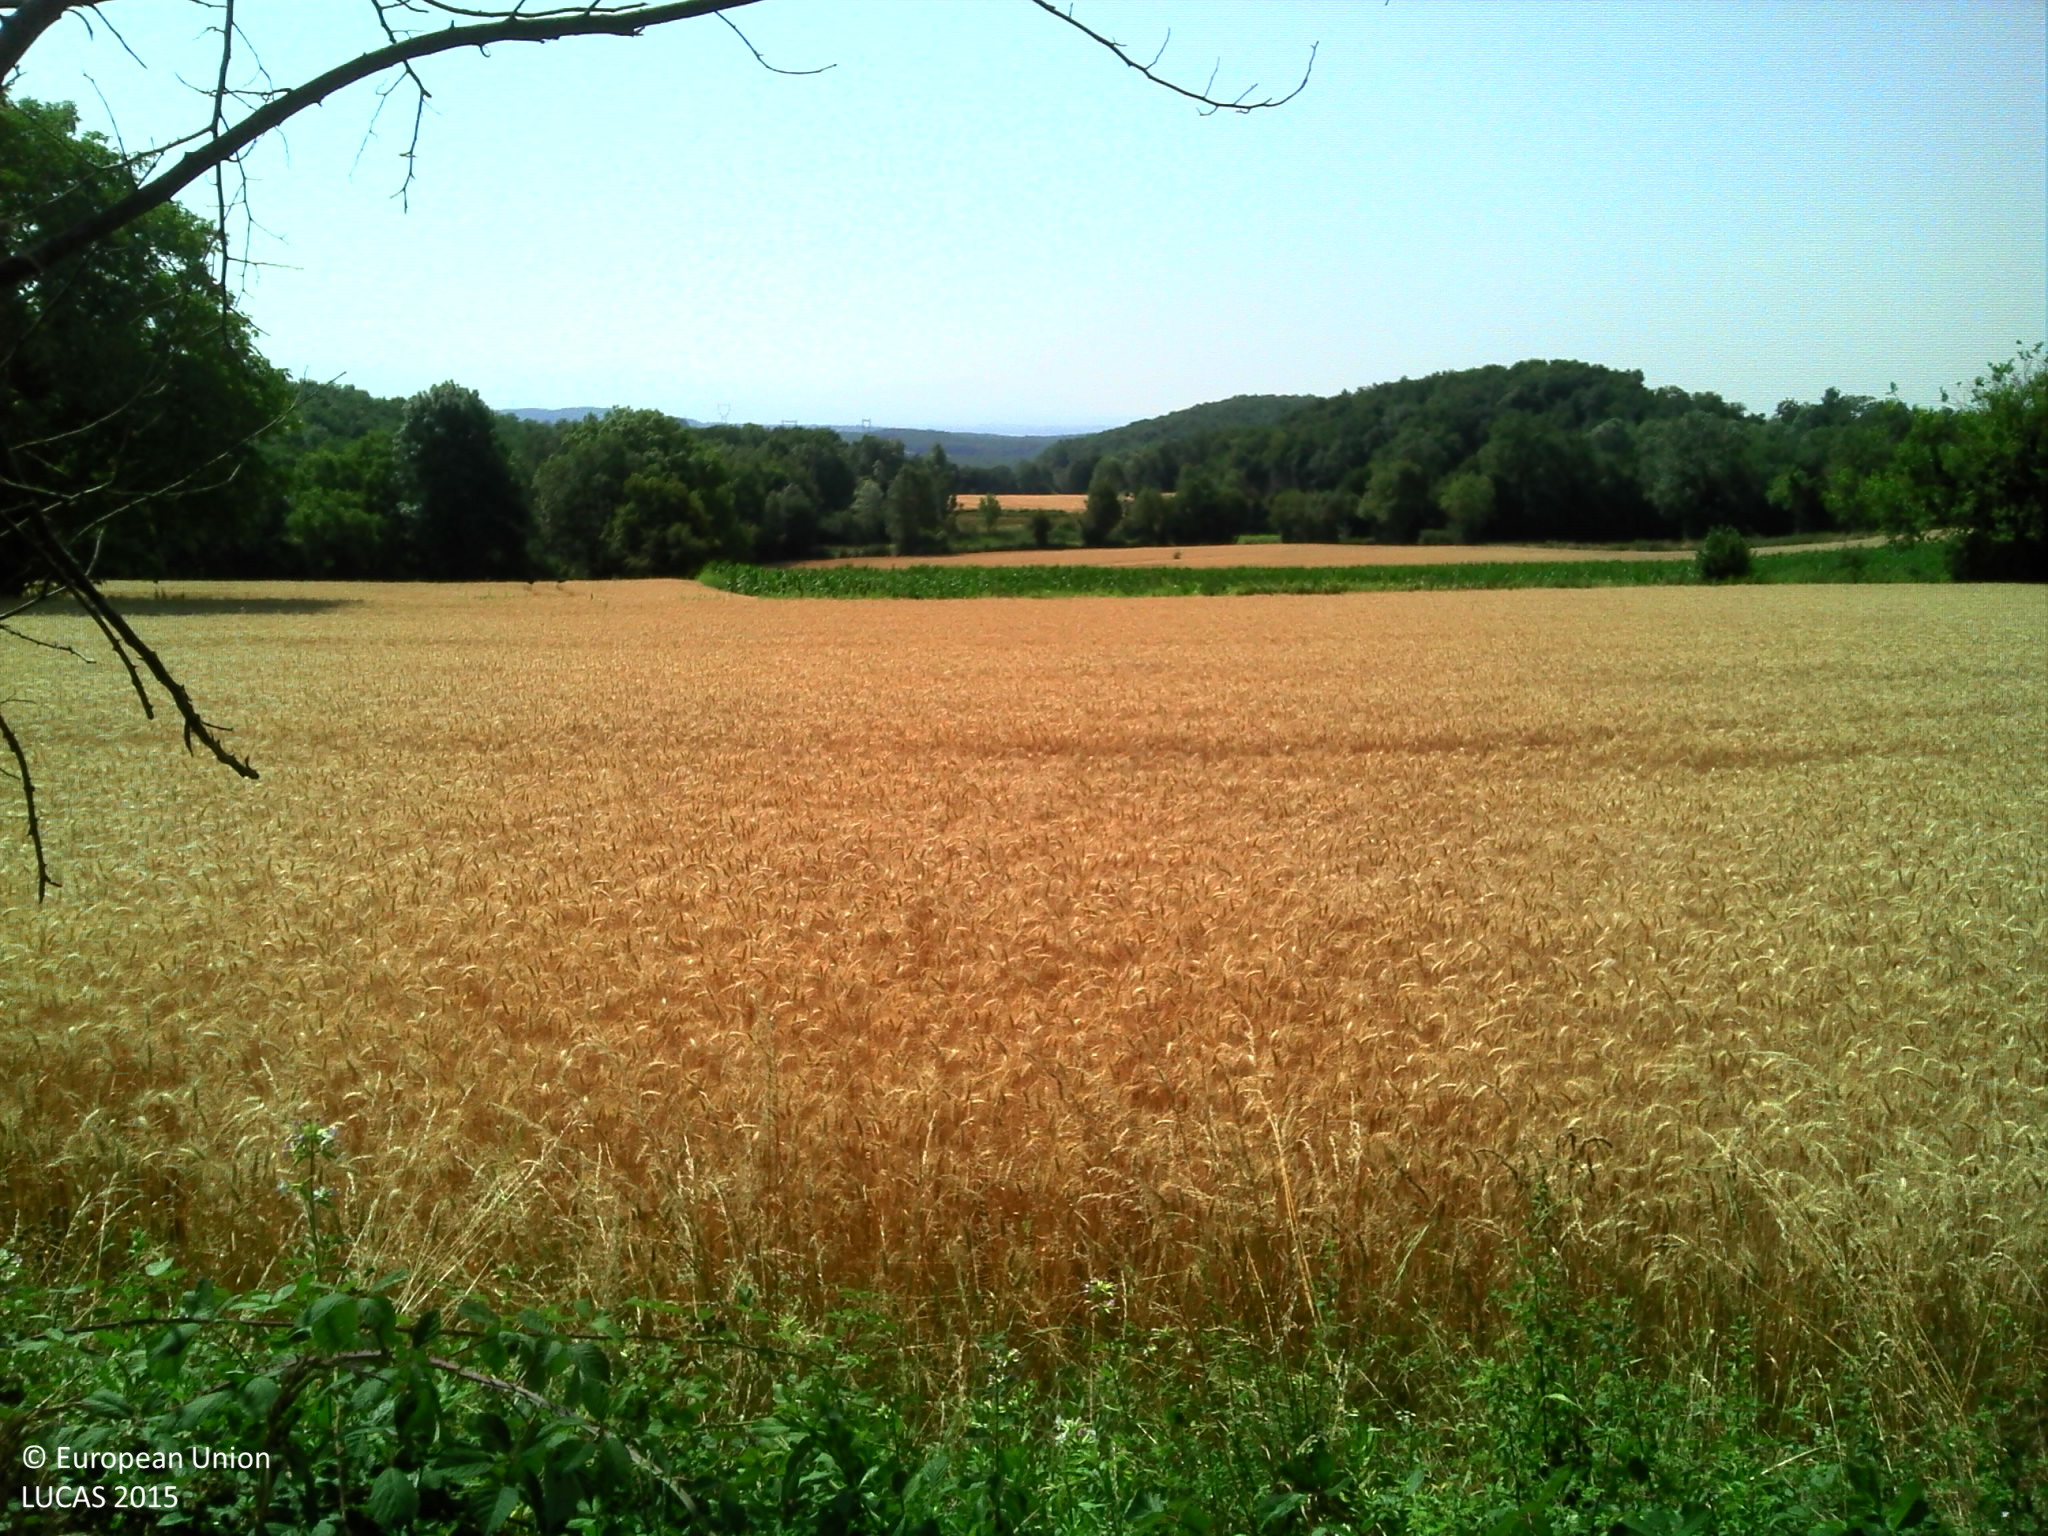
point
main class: Cropland
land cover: Durum wheat
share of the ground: > 75 %
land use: Agriculture (excluding fallow land and kitchen gardens)
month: July
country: FR
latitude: 45.7837
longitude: 5.4121
